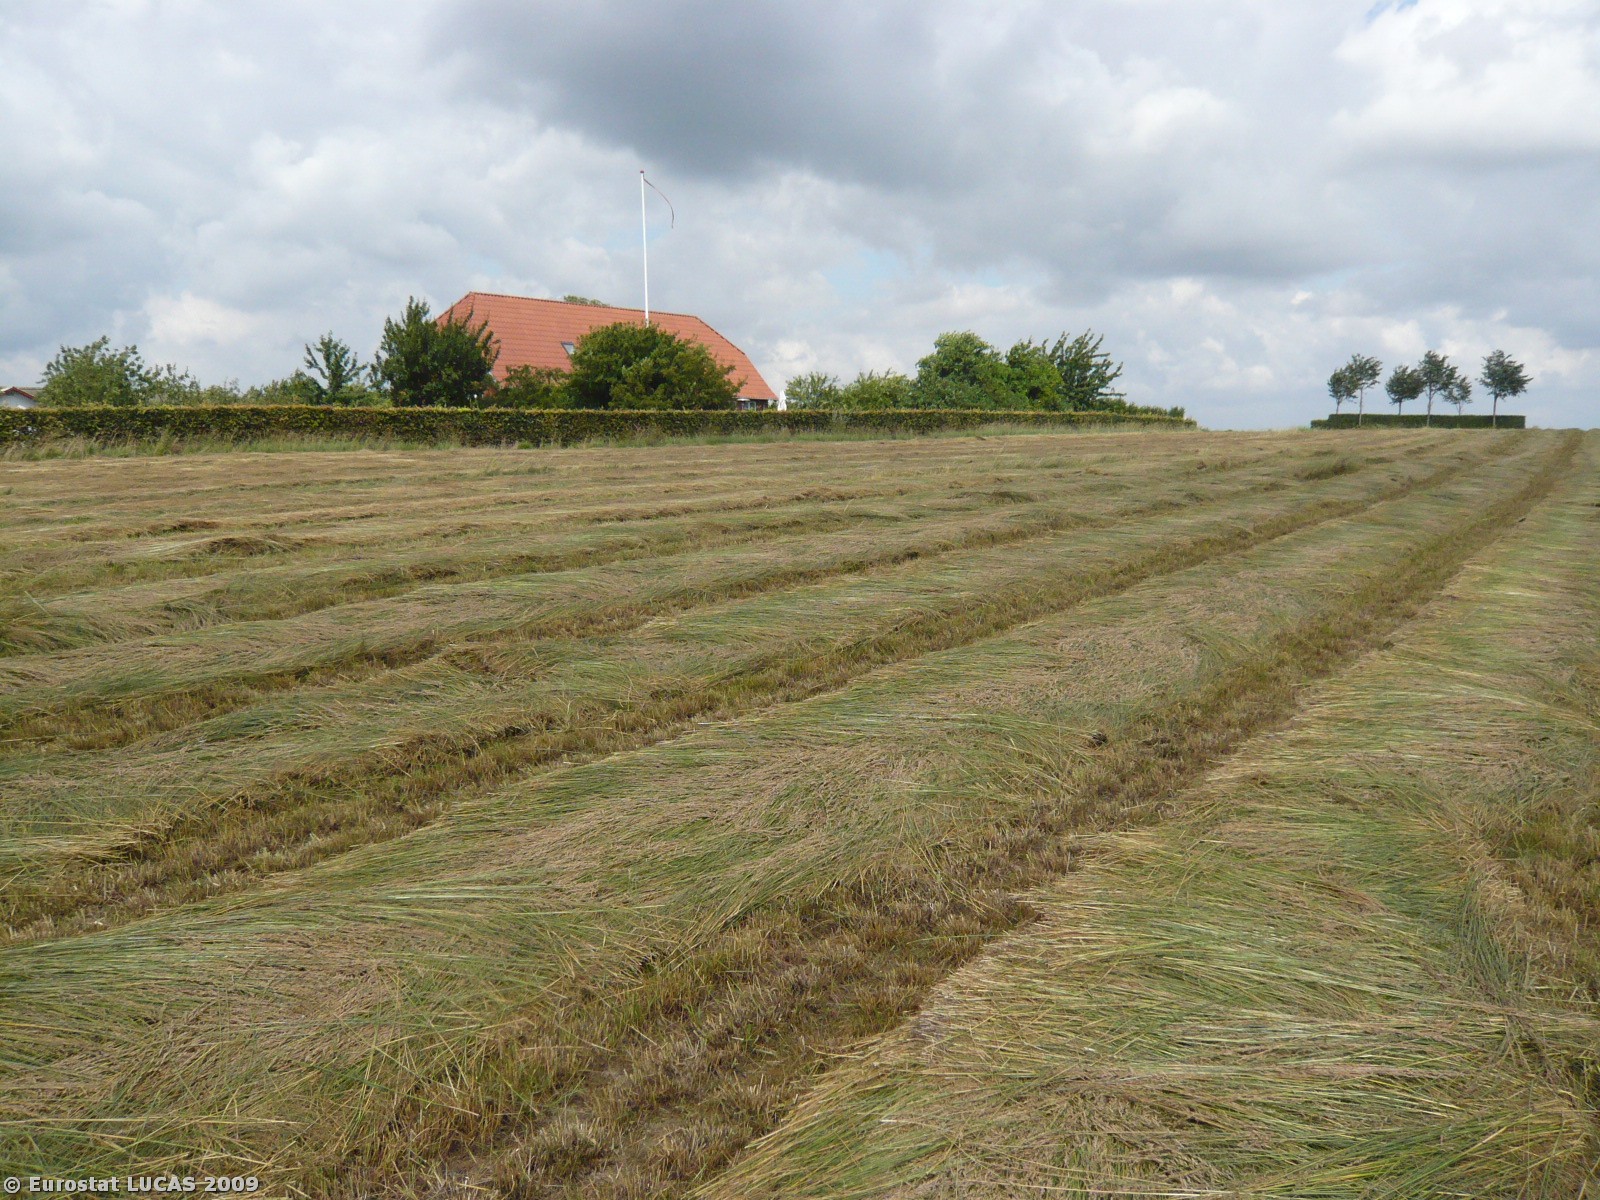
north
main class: Cropland
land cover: Temporary grasslands
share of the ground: > 75 %
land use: Agriculture (excluding fallow land and kitchen gardens)
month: July
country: DK
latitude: 55.4888
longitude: 12.0083
